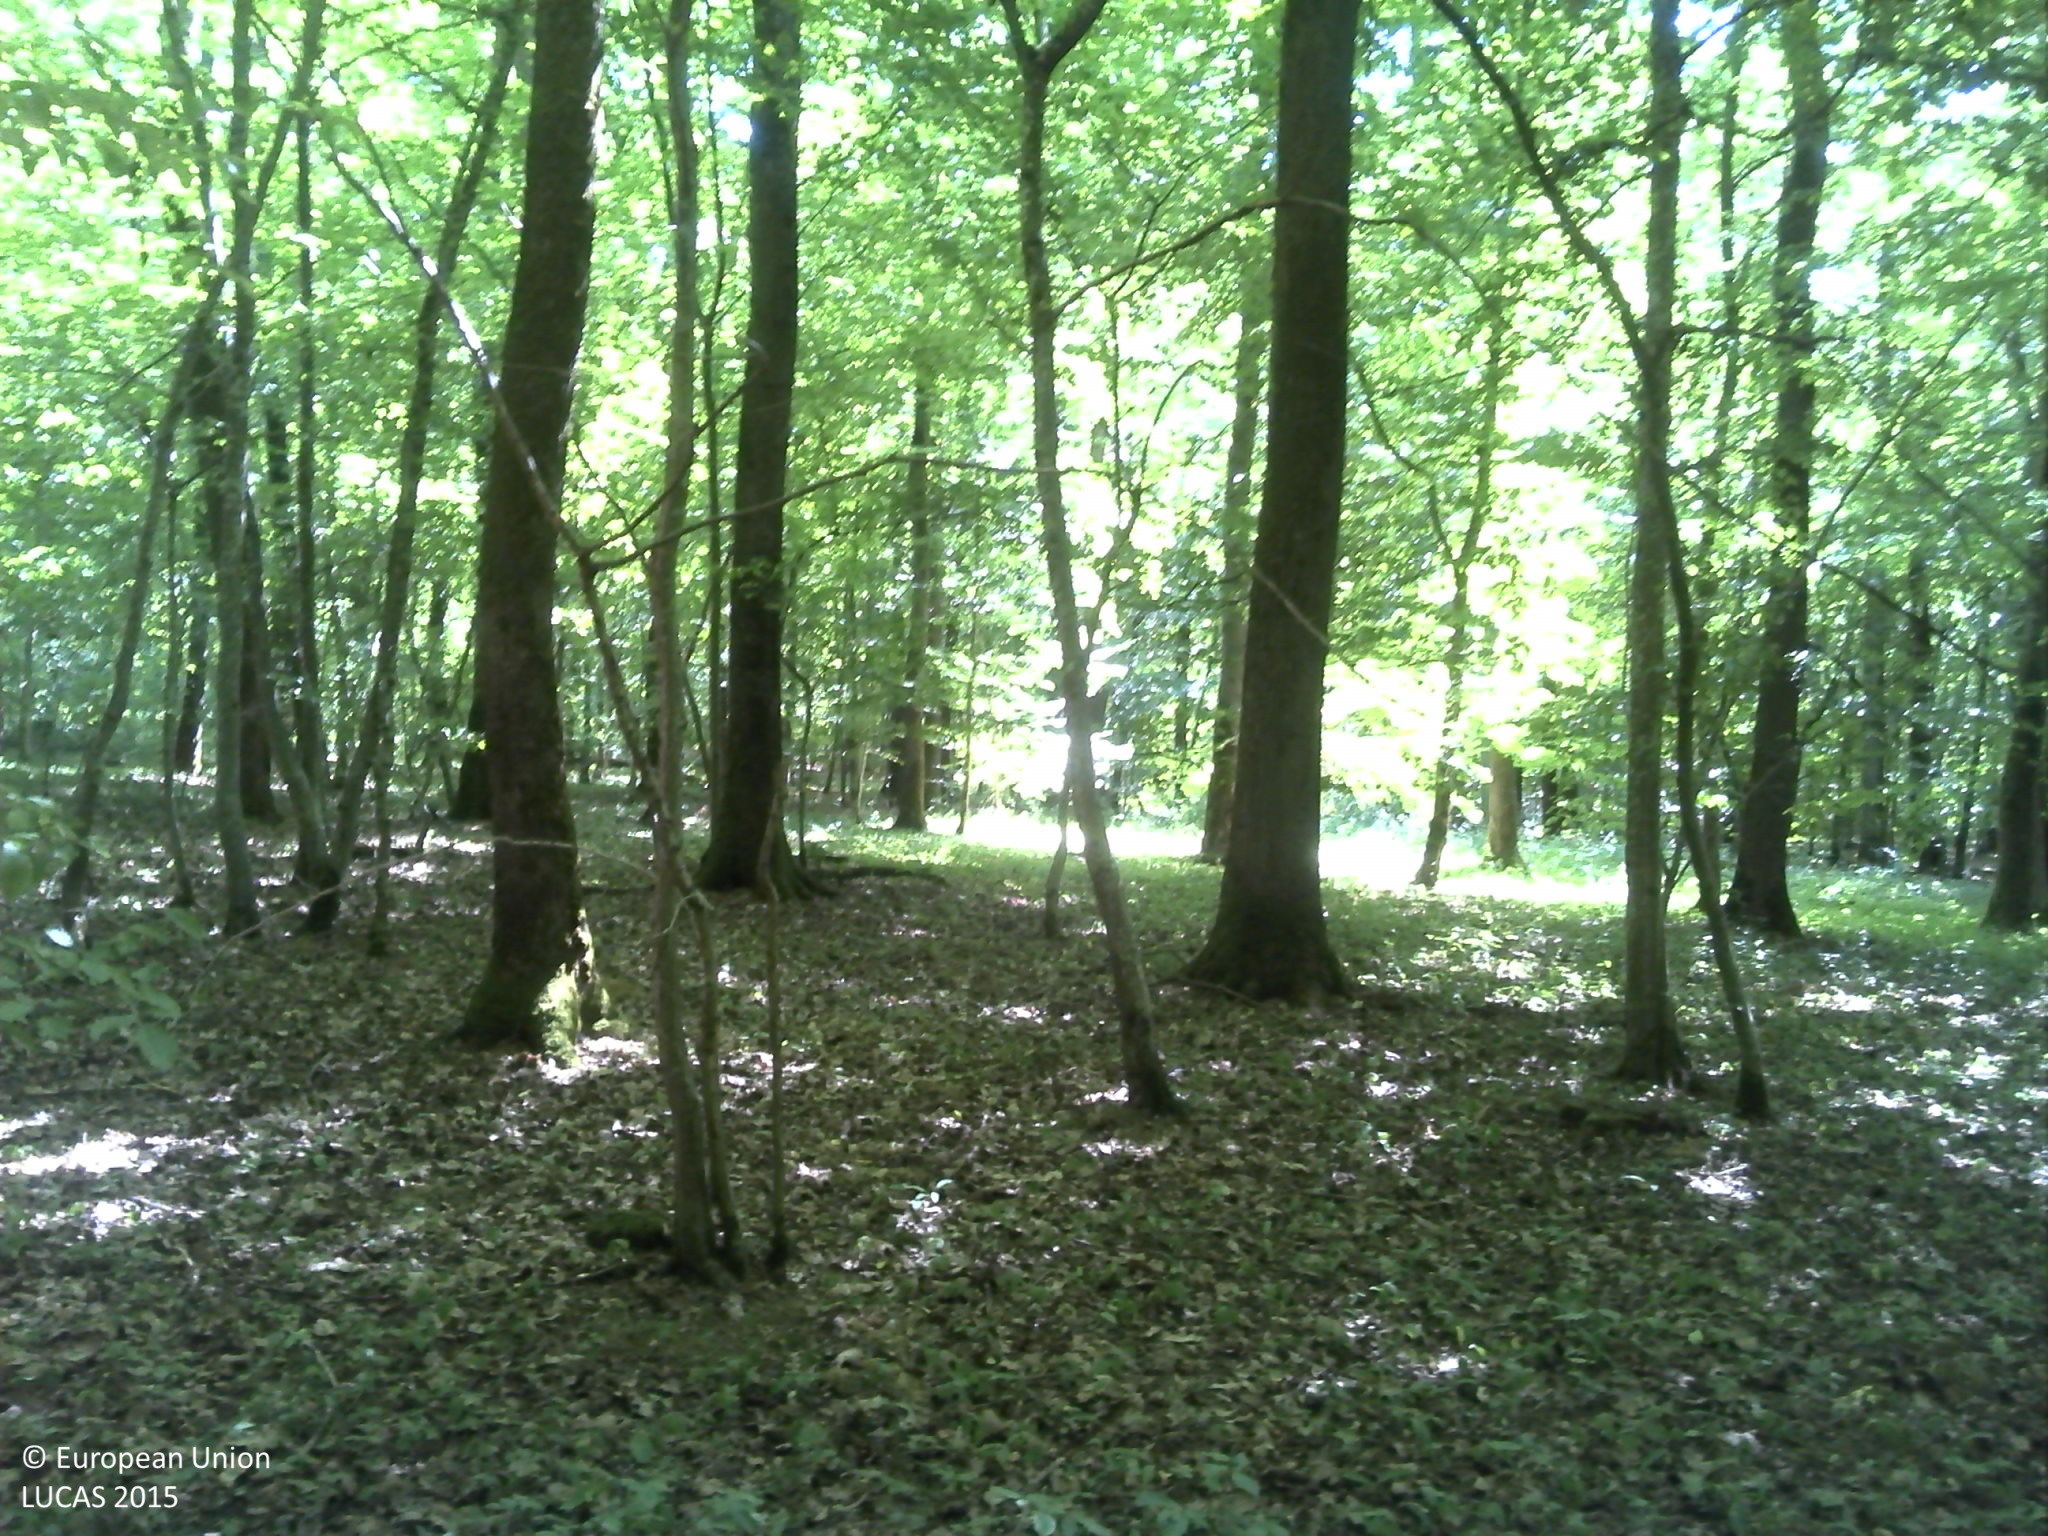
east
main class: Woodland
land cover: Broadleaved woodland
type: mesophytic deciduous forest
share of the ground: > 75 %
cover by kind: broadleaved forest trees 100 %
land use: Forestry
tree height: > 5 m
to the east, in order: Broadleaved woodland; Inland marshes; Broadleaved woodland
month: July
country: FR
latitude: 49.4711
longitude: 6.1494
